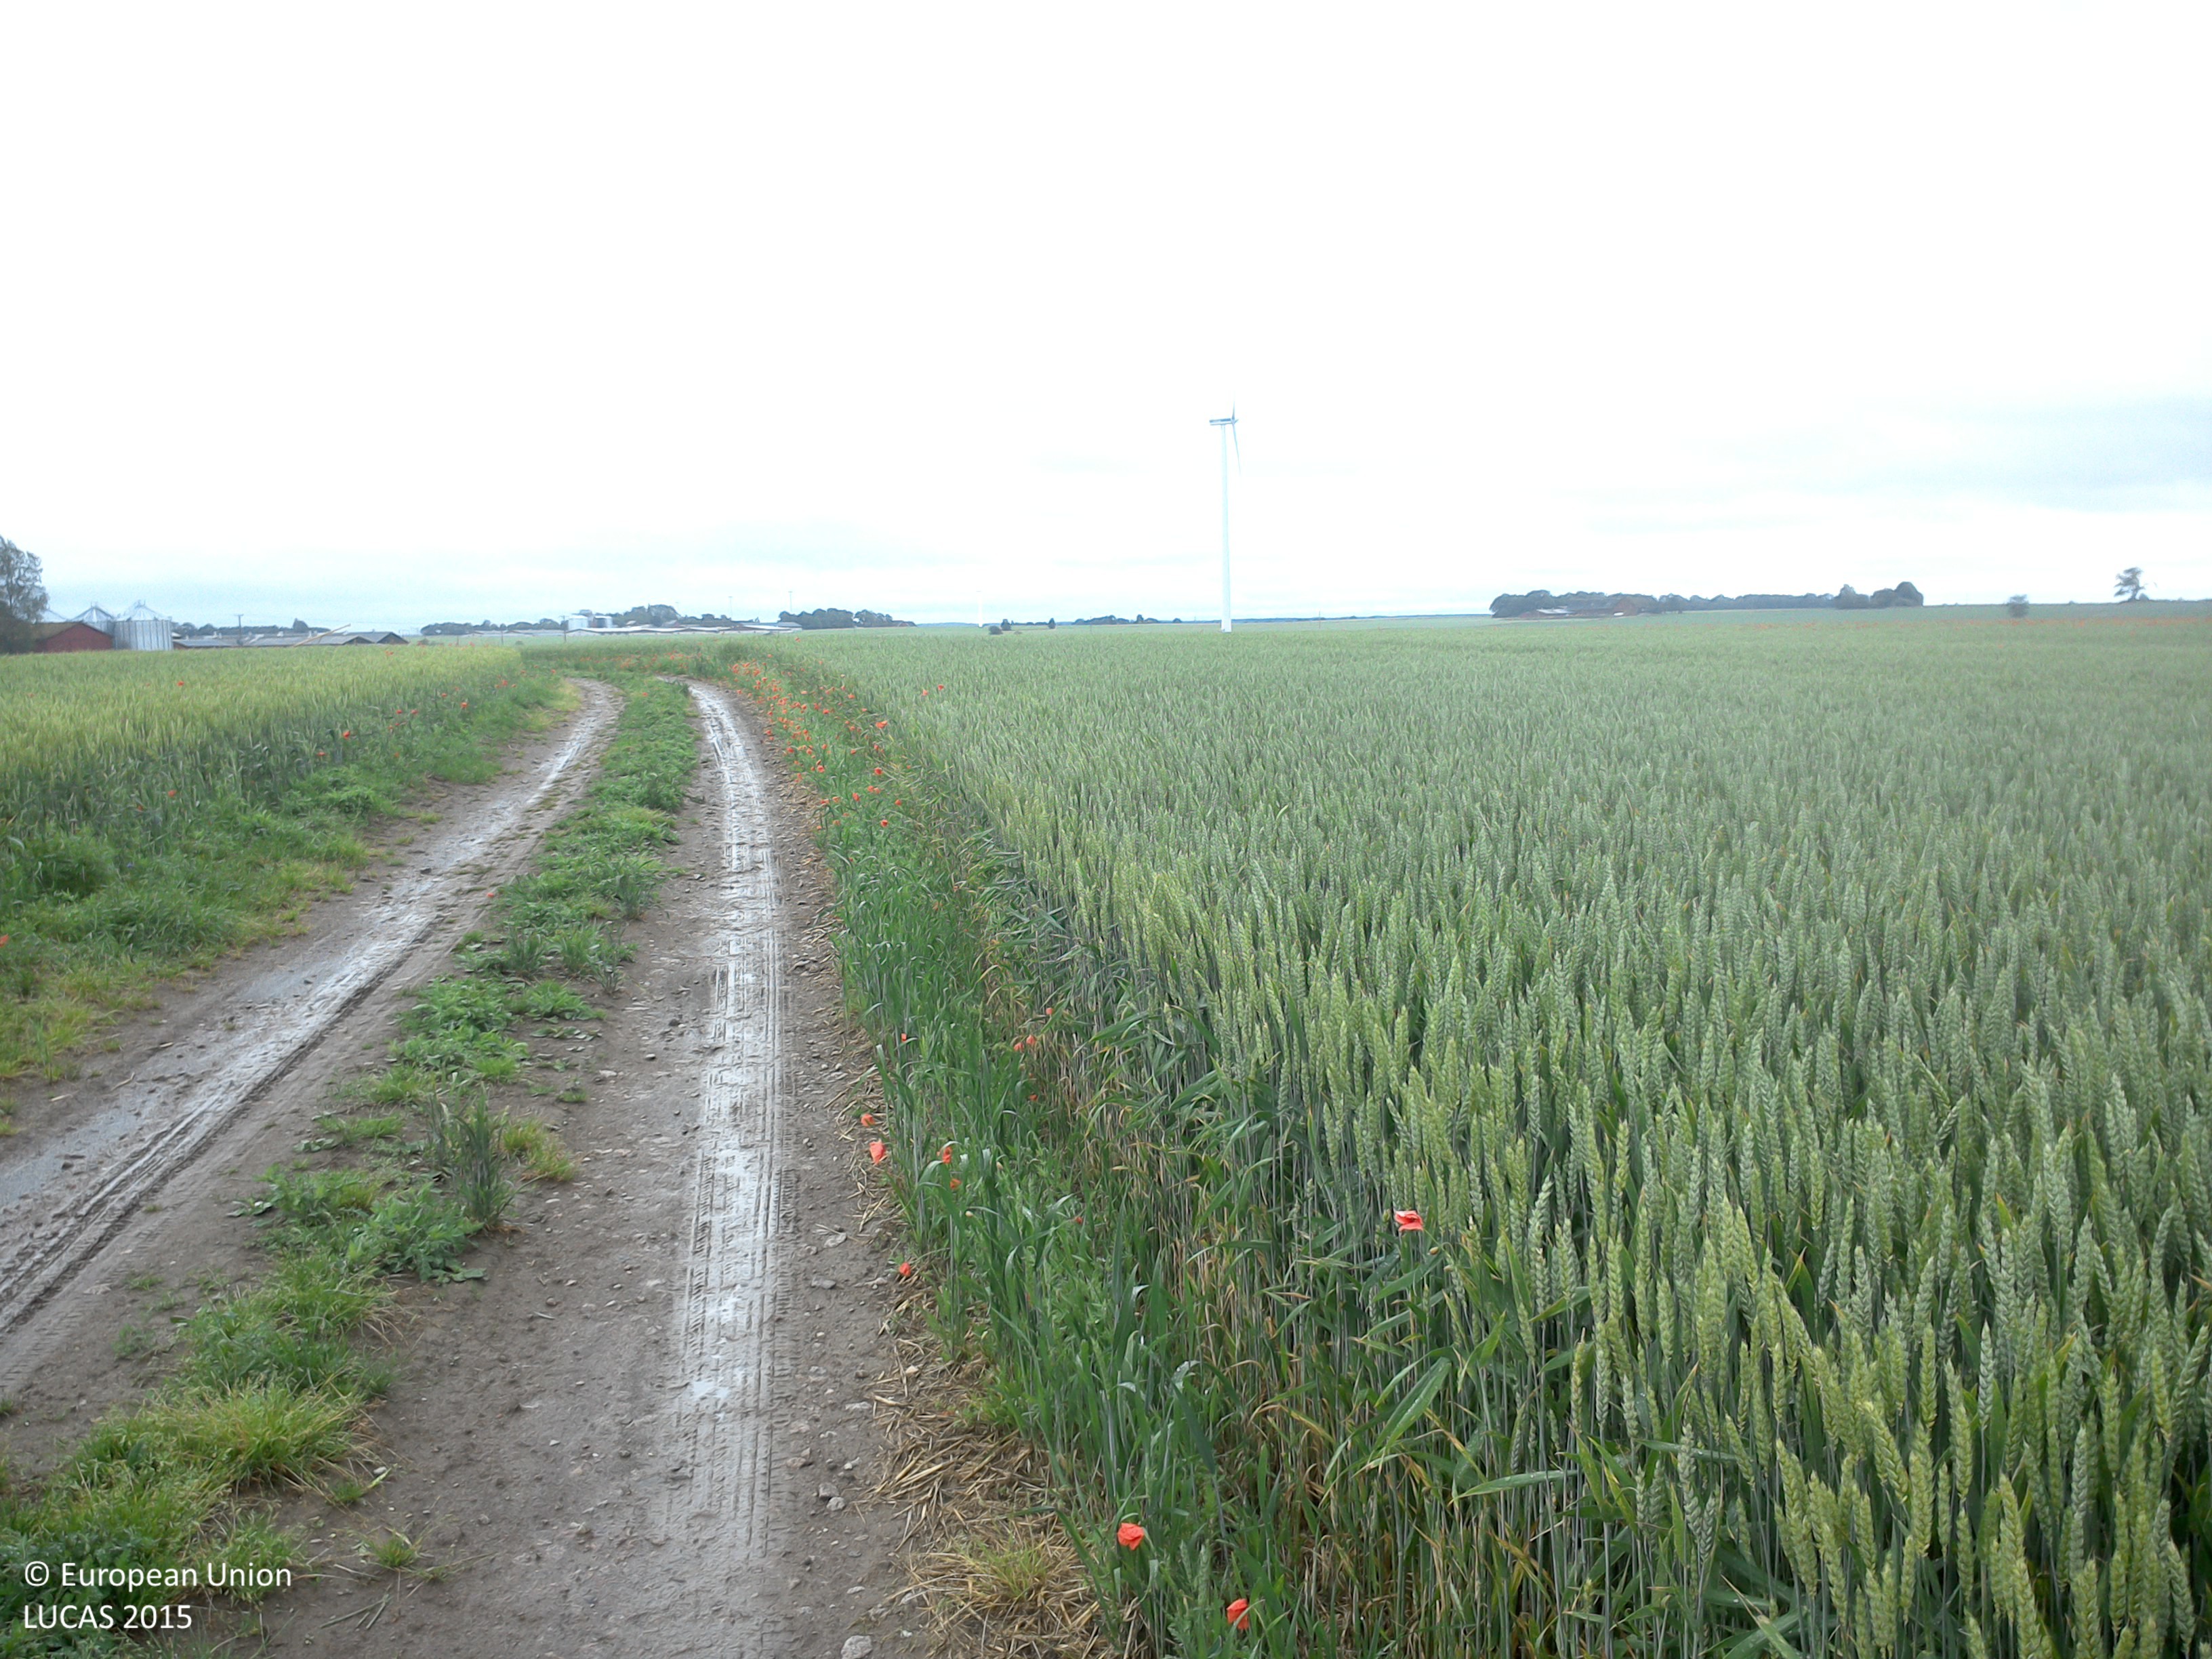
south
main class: Cropland
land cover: Common wheat
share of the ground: > 75 %
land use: Agriculture (excluding fallow land and kitchen gardens)
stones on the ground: < 10 %
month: July
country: SE
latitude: 58.3621
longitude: 14.9679
